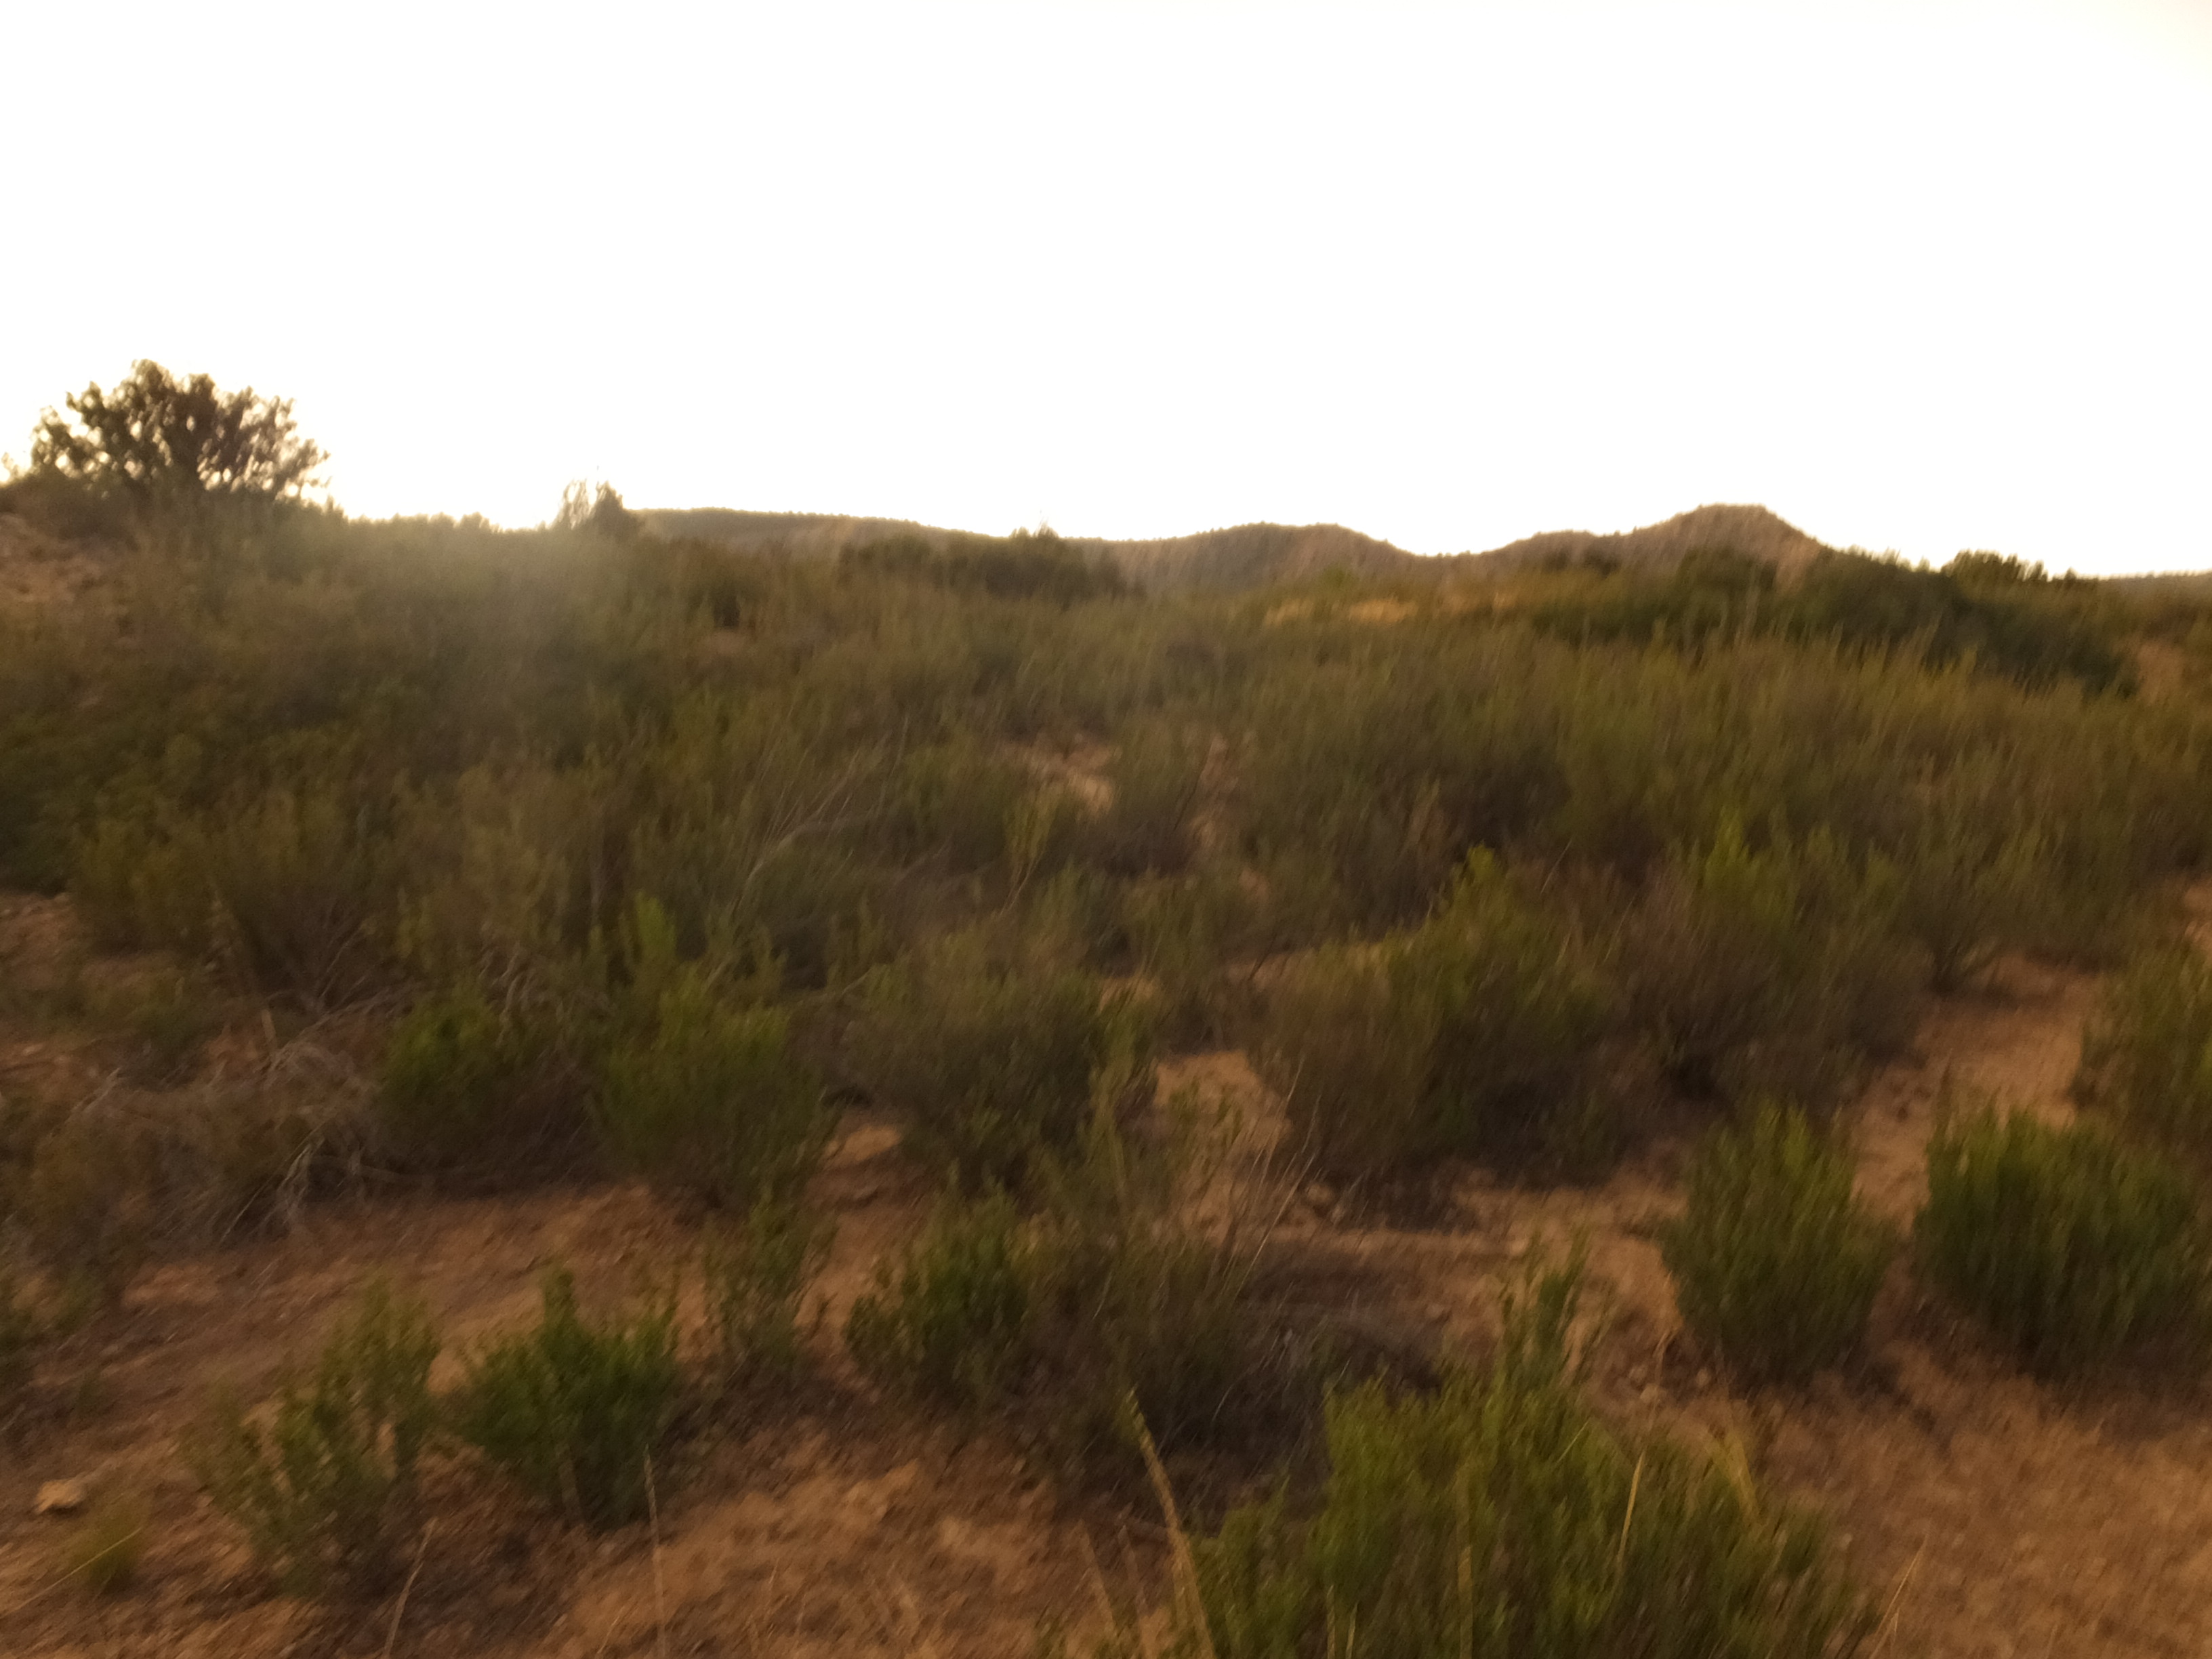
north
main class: Shrubland
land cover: Shrubland with sparse tree cover
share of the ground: > 75 %
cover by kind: shrubs 70 %, herbaceous plants 20 %, coniferous forest trees 5 %, consolidated bare surface 5 %
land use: Semi-natural and natural areas not in use
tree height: < 5 m
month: August
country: ES
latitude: 41.3473
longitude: 0.0794
